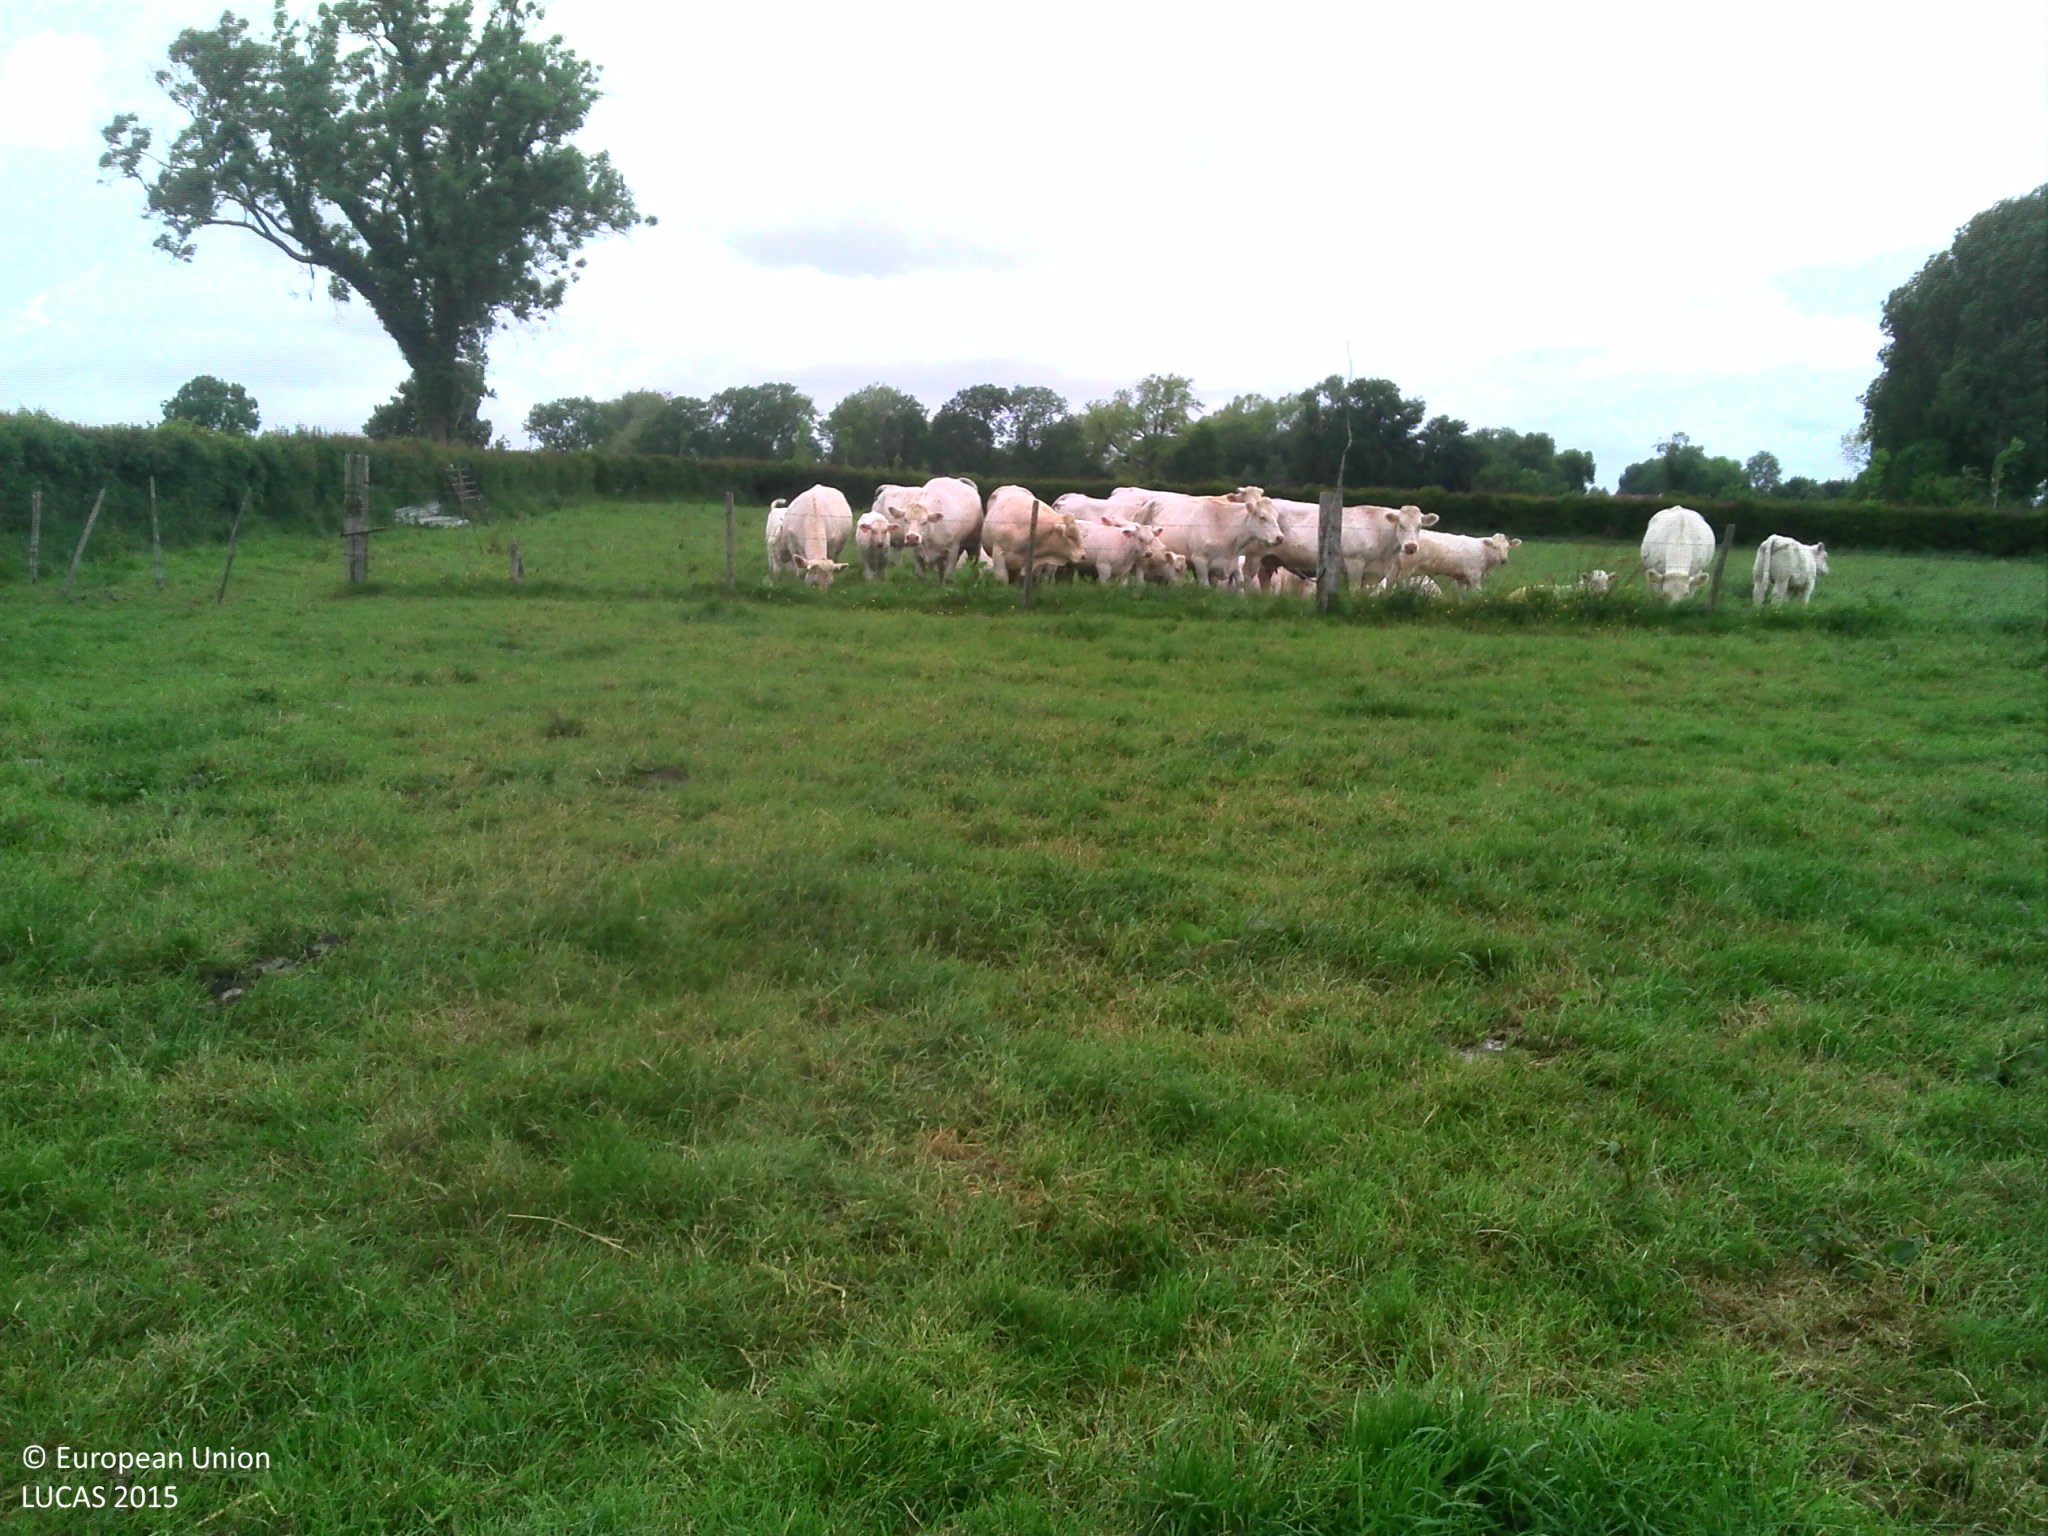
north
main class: Grassland
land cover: Grassland without tree/shrub cover
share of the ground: > 75 %
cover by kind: herbaceous plants 100 %
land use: Agriculture (excluding fallow land and kitchen gardens)
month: May
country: FR
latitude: 50.0599
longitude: 1.6710
